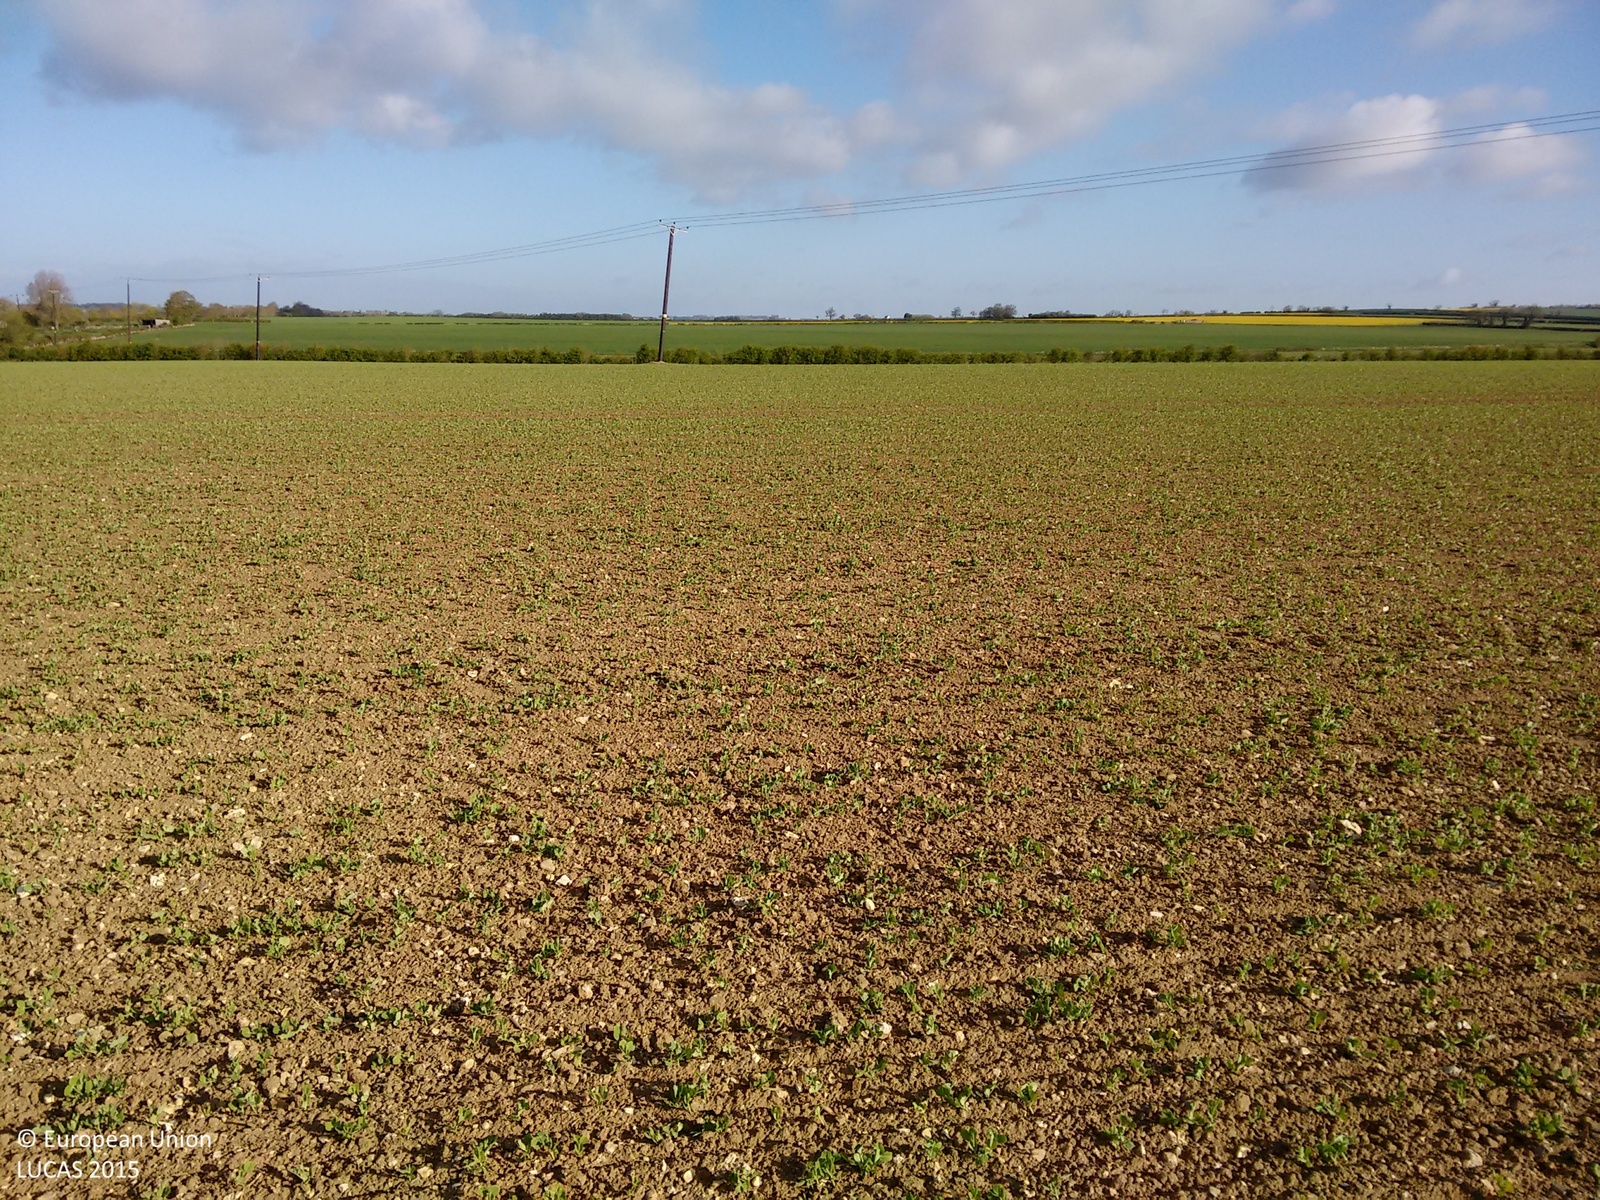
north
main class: Cropland
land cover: Dry pulses
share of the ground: < 10 %
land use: Agriculture (excluding fallow land and kitchen gardens)
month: April
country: GB
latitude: 53.2311
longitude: -0.1153
